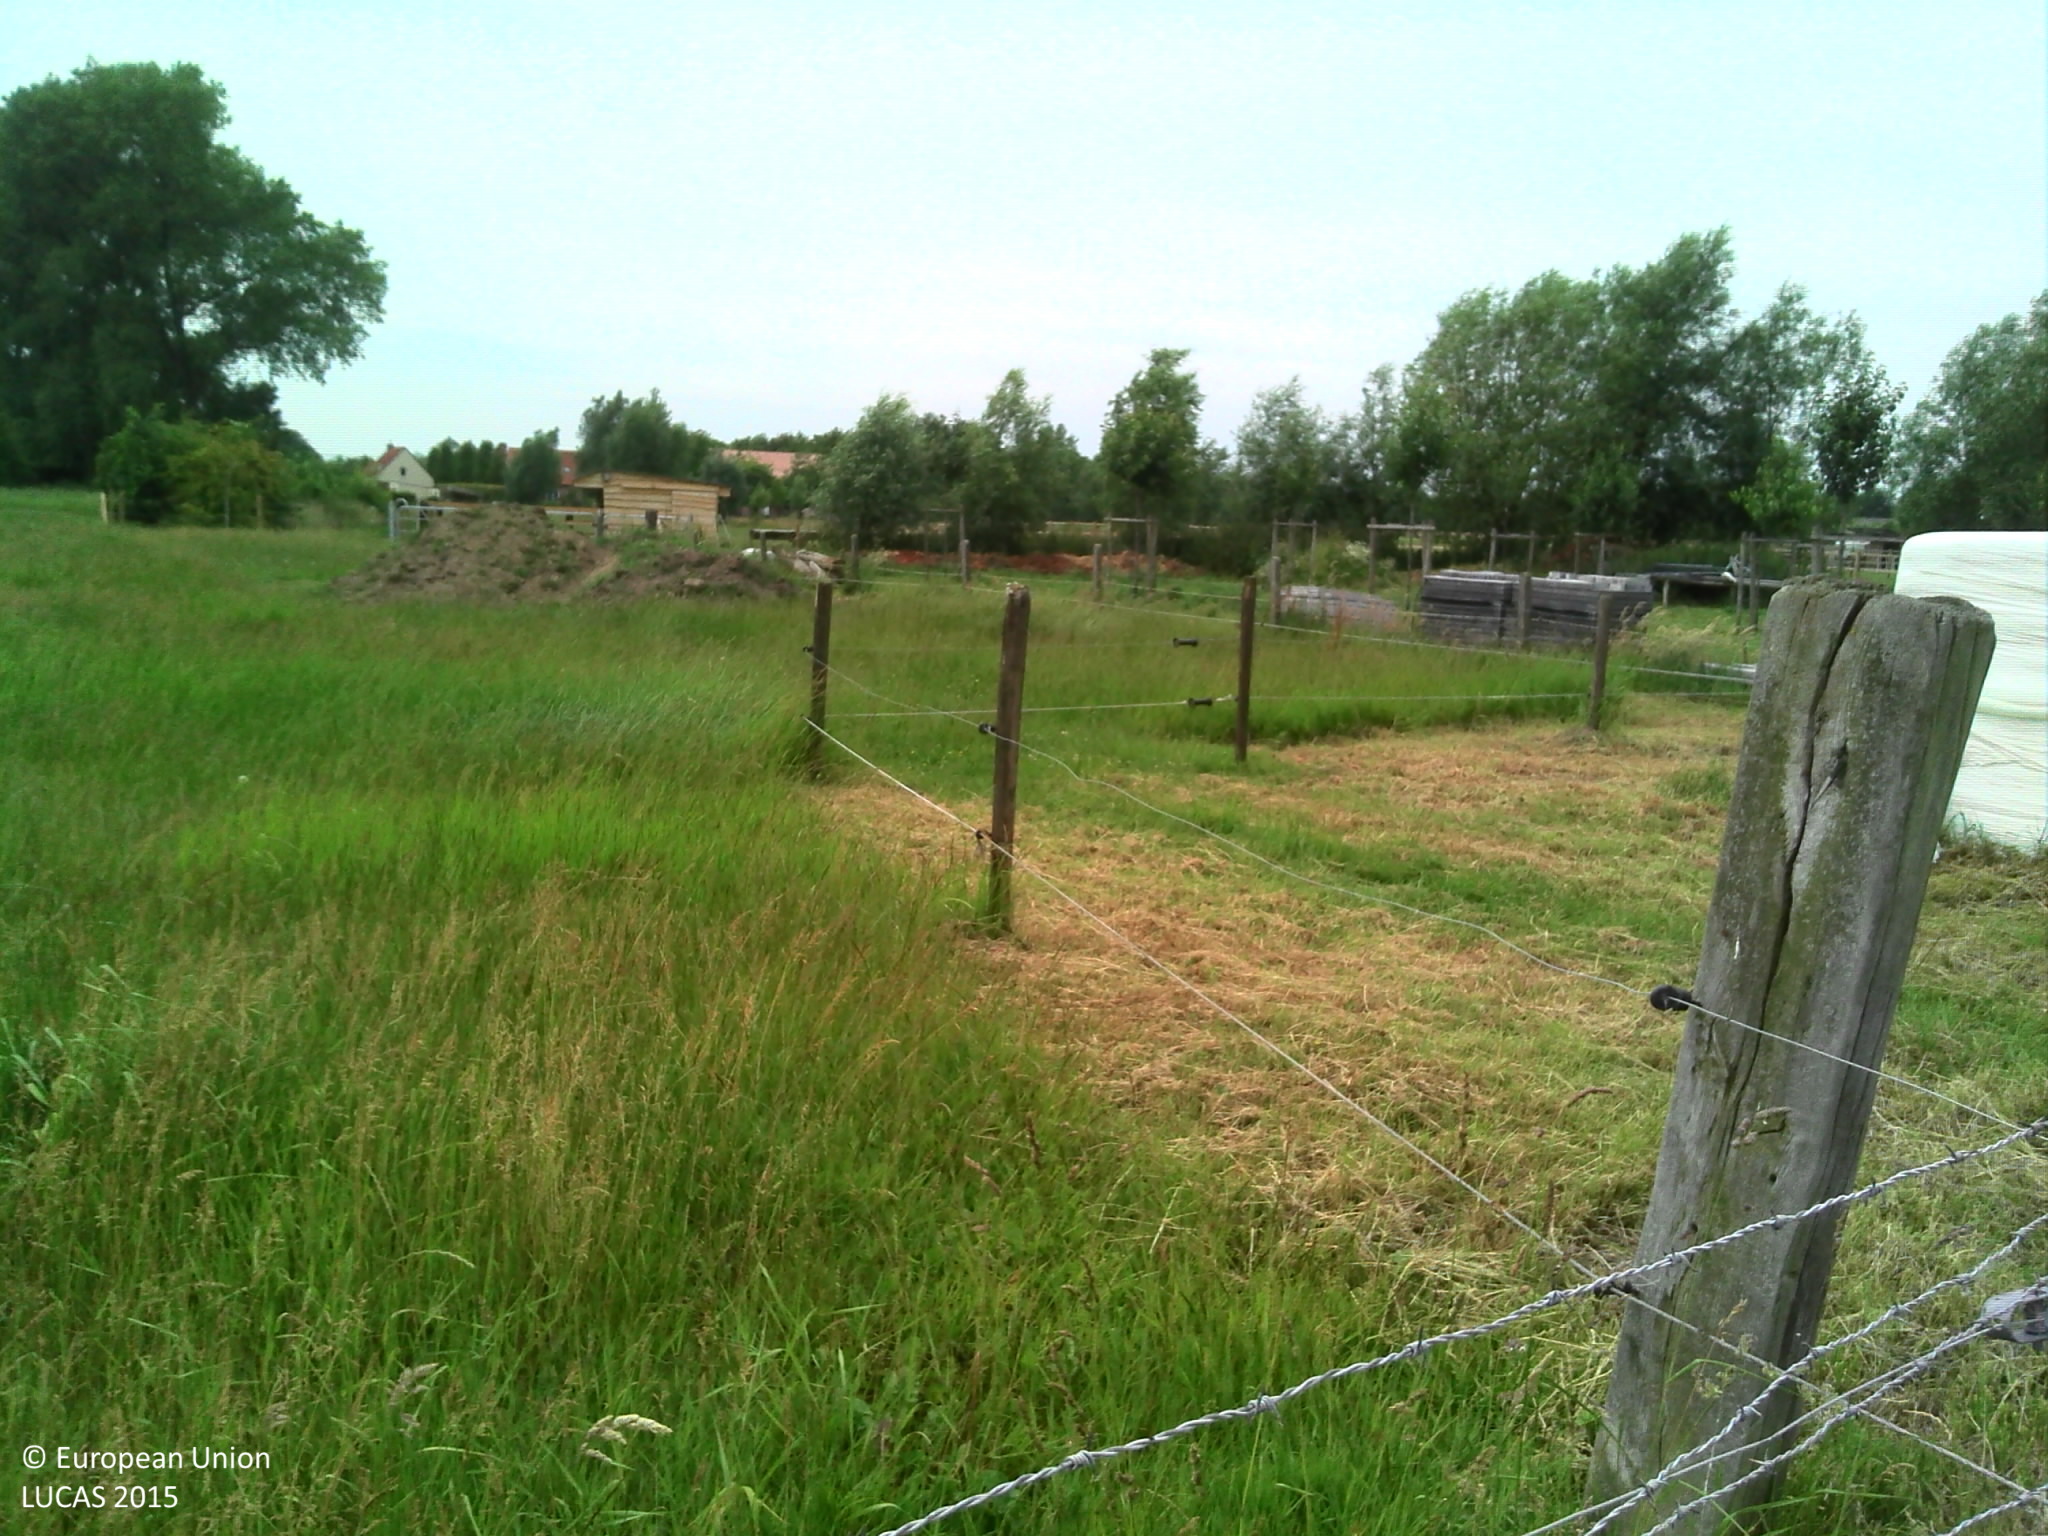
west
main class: Grassland
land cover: Grassland without tree/shrub cover
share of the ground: > 75 %
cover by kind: herbaceous plants 100 %
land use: Agriculture (excluding fallow land and kitchen gardens)
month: June
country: BE
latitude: 50.9509
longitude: 3.4297
